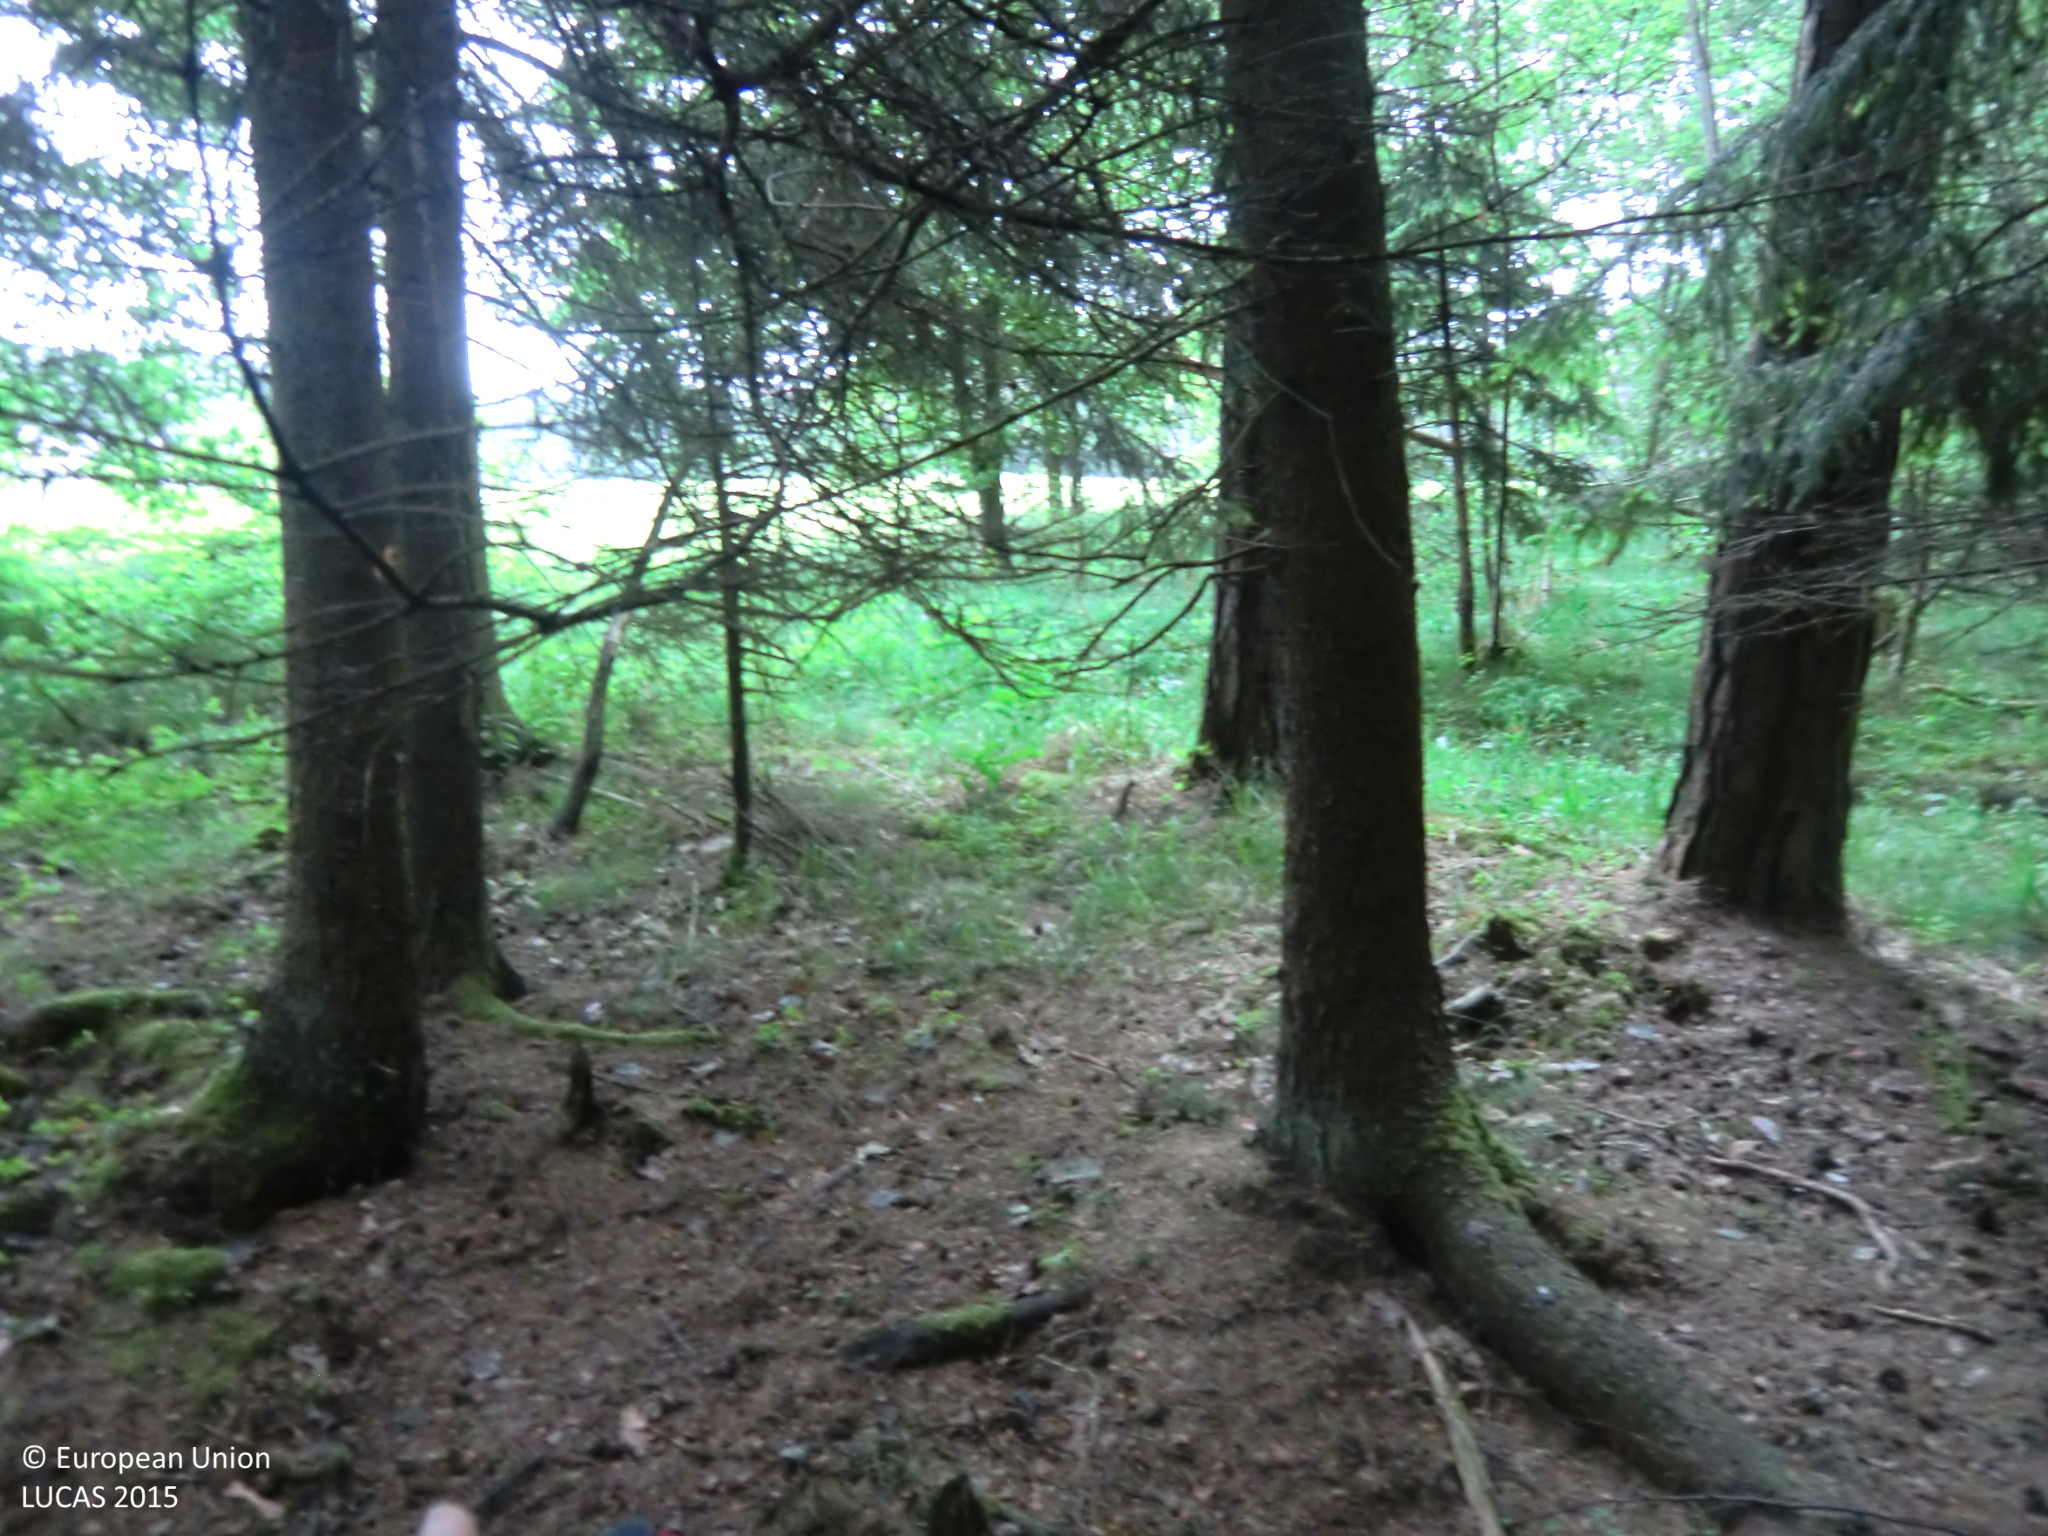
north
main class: Woodland
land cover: Pine dominated mixed woodland
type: hemiboreal forest and nemoral coniferous forest and mixed broadleaved-coniferous forest
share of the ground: > 75 %
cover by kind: coniferous forest trees 40 %, broadleaved forest trees 40 %, shrubs 10 %, herbaceous plants 10 %
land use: Forestry
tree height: > 5 m
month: May
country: AT
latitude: 48.3684
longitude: 14.4415
